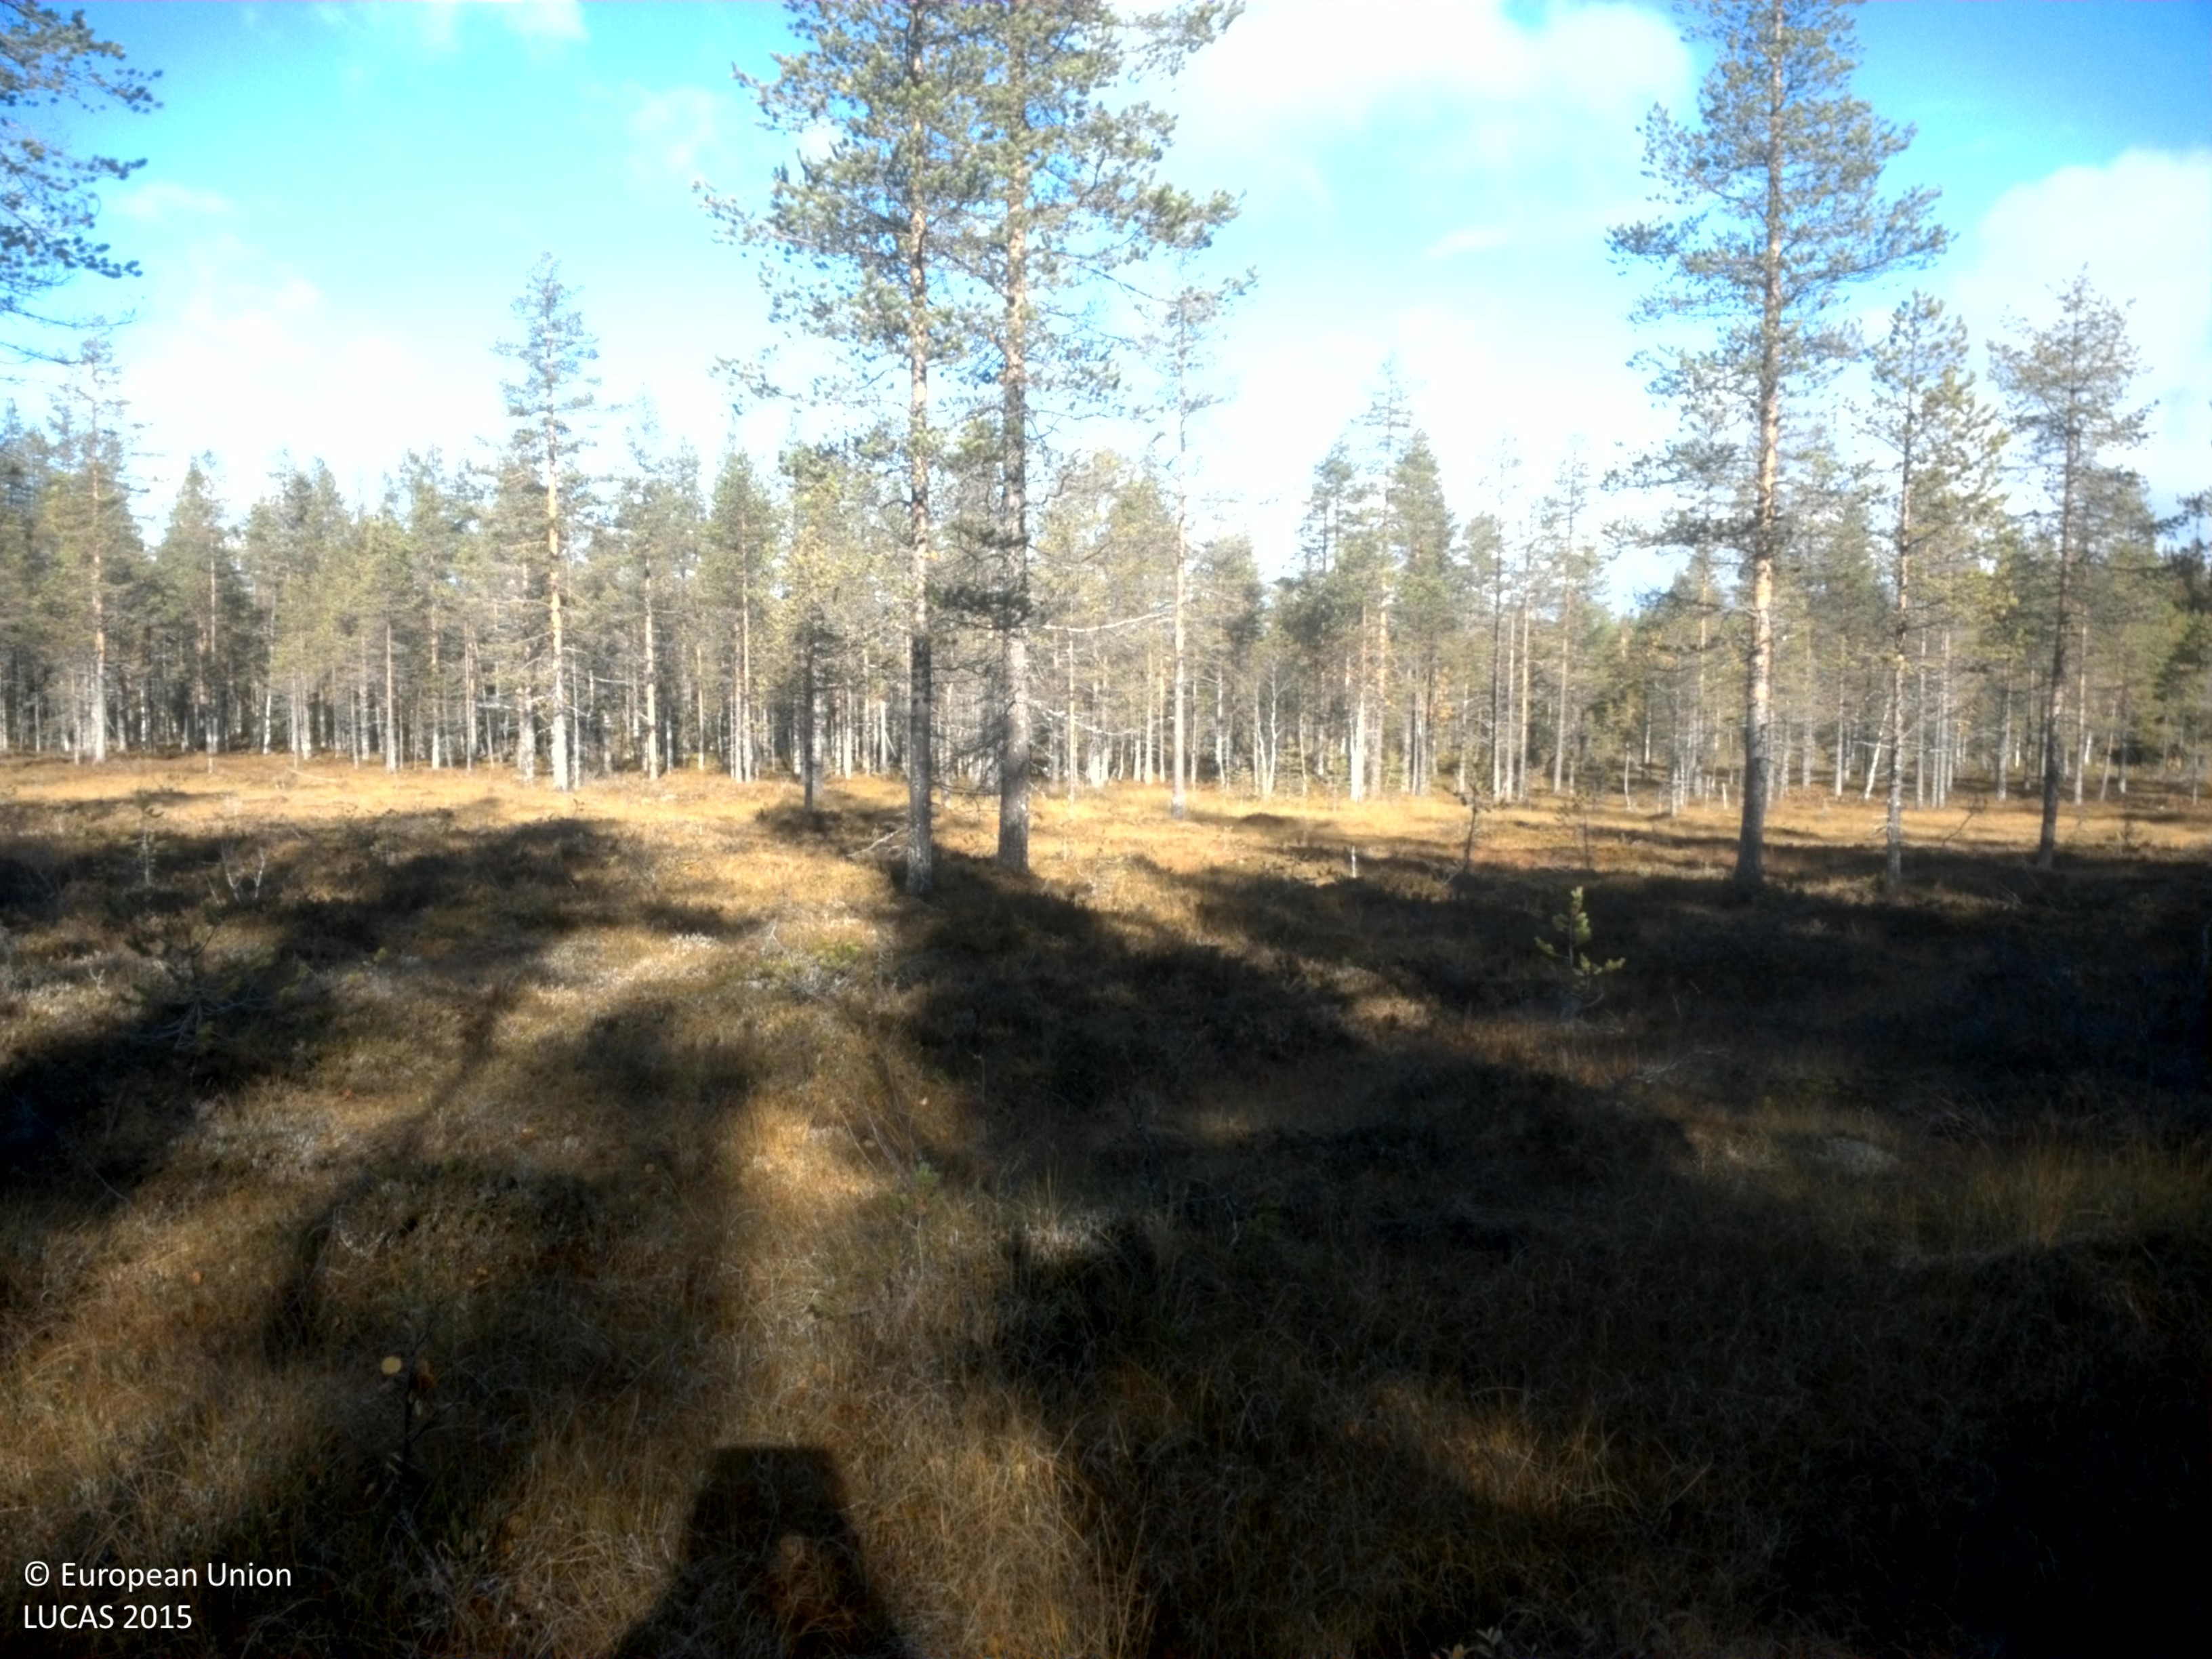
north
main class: Woodland
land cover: Pine dominated coniferous woodland
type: boreal forest
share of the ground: 10 - 25 %
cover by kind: shrubs 40 %, herbaceous plants 35 %, lichens and mosses 15 %, coniferous forest trees 10 %
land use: Semi-natural and natural areas not in use
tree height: > 5 m
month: September
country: SE
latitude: 64.2675
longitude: 19.9467
